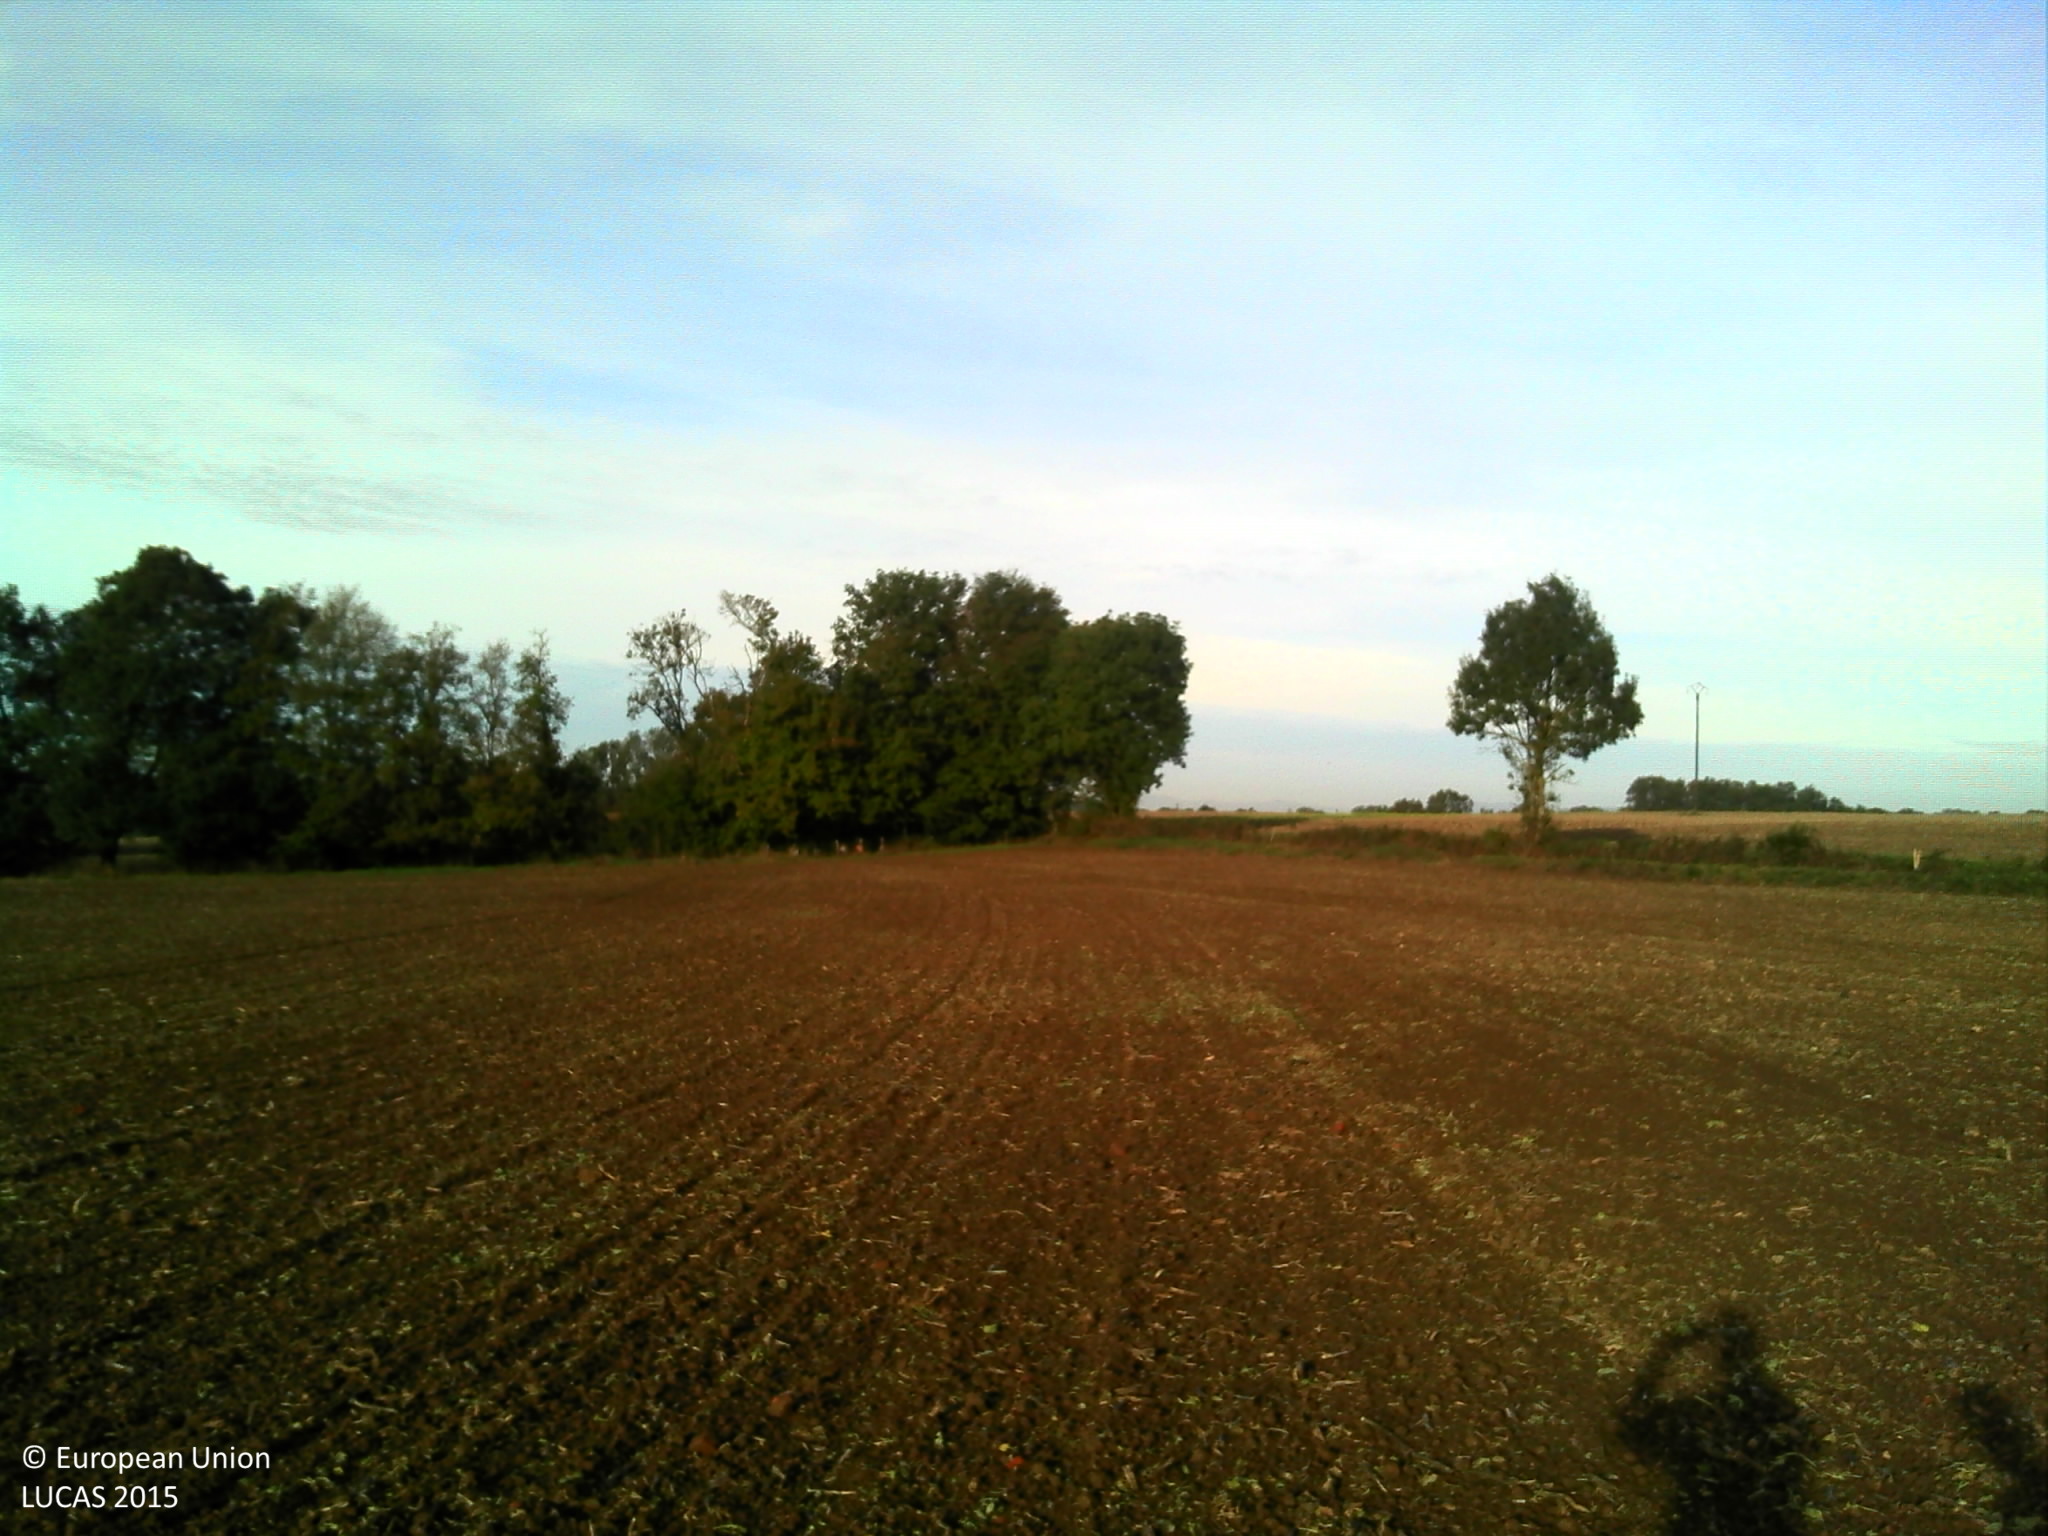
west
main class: Cropland
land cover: Sunflower
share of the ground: > 75 %
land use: Agriculture (excluding fallow land and kitchen gardens)
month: October
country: FR
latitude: 46.3989
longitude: 5.0470
